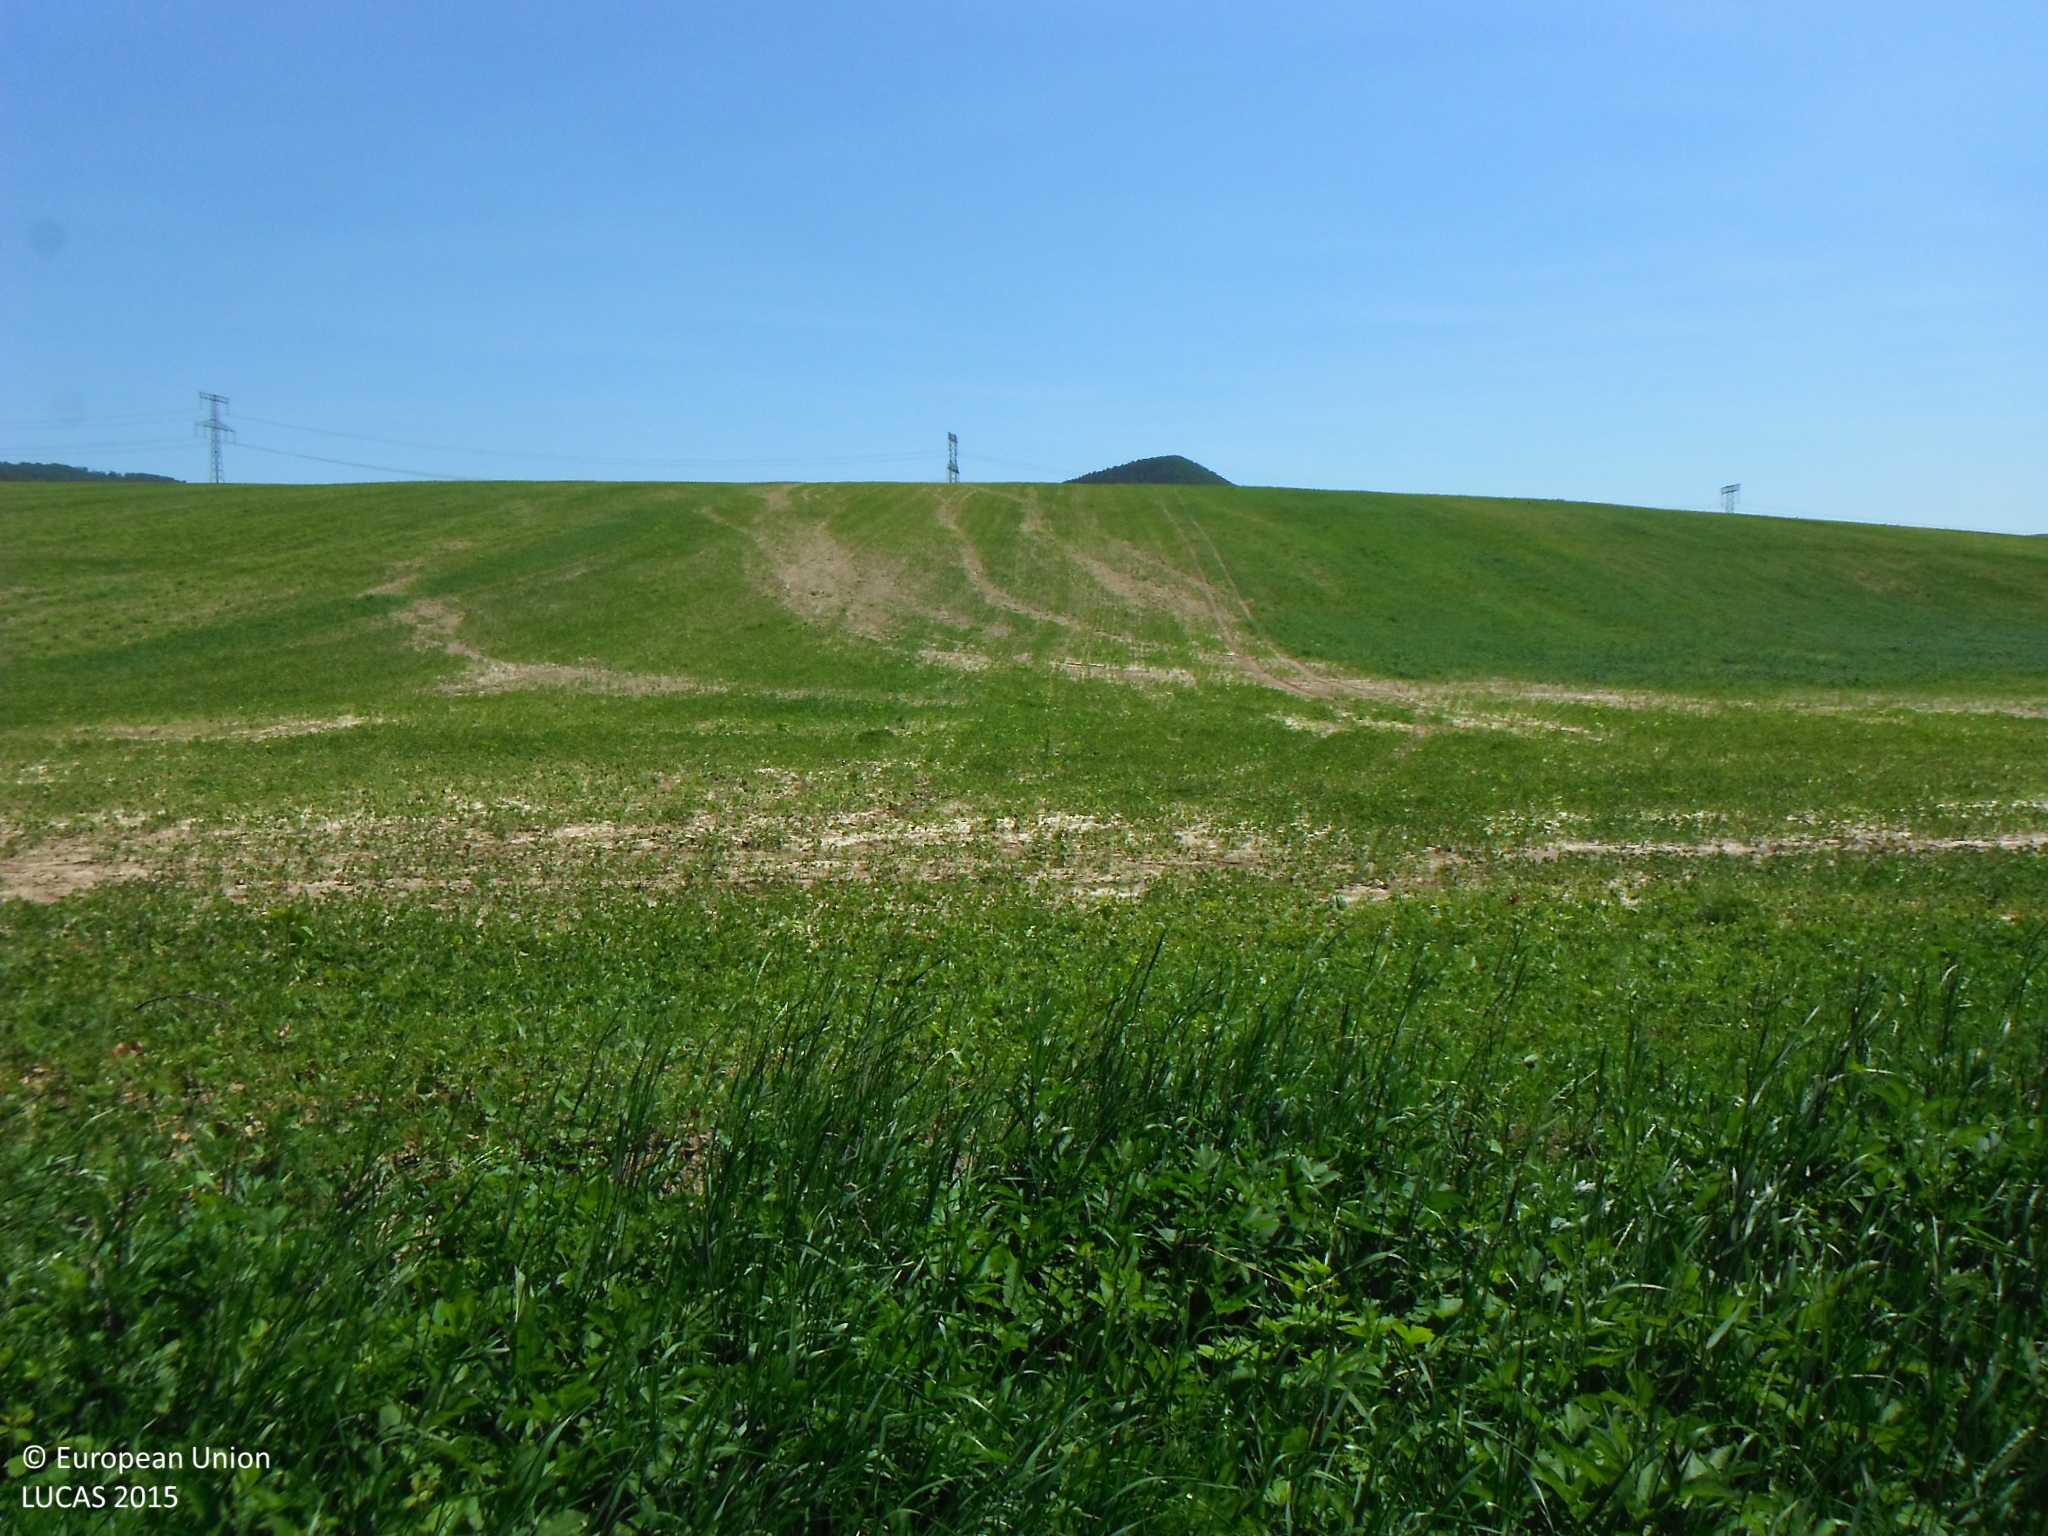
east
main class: Grassland
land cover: Spontaneously vegetated surfaces
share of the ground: > 75 %
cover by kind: herbaceous plants 100 %
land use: Semi-natural and natural areas not in use
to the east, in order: Spontaneously vegetated surfaces; Soya
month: June
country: SK
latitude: 48.8736
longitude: 21.3213
